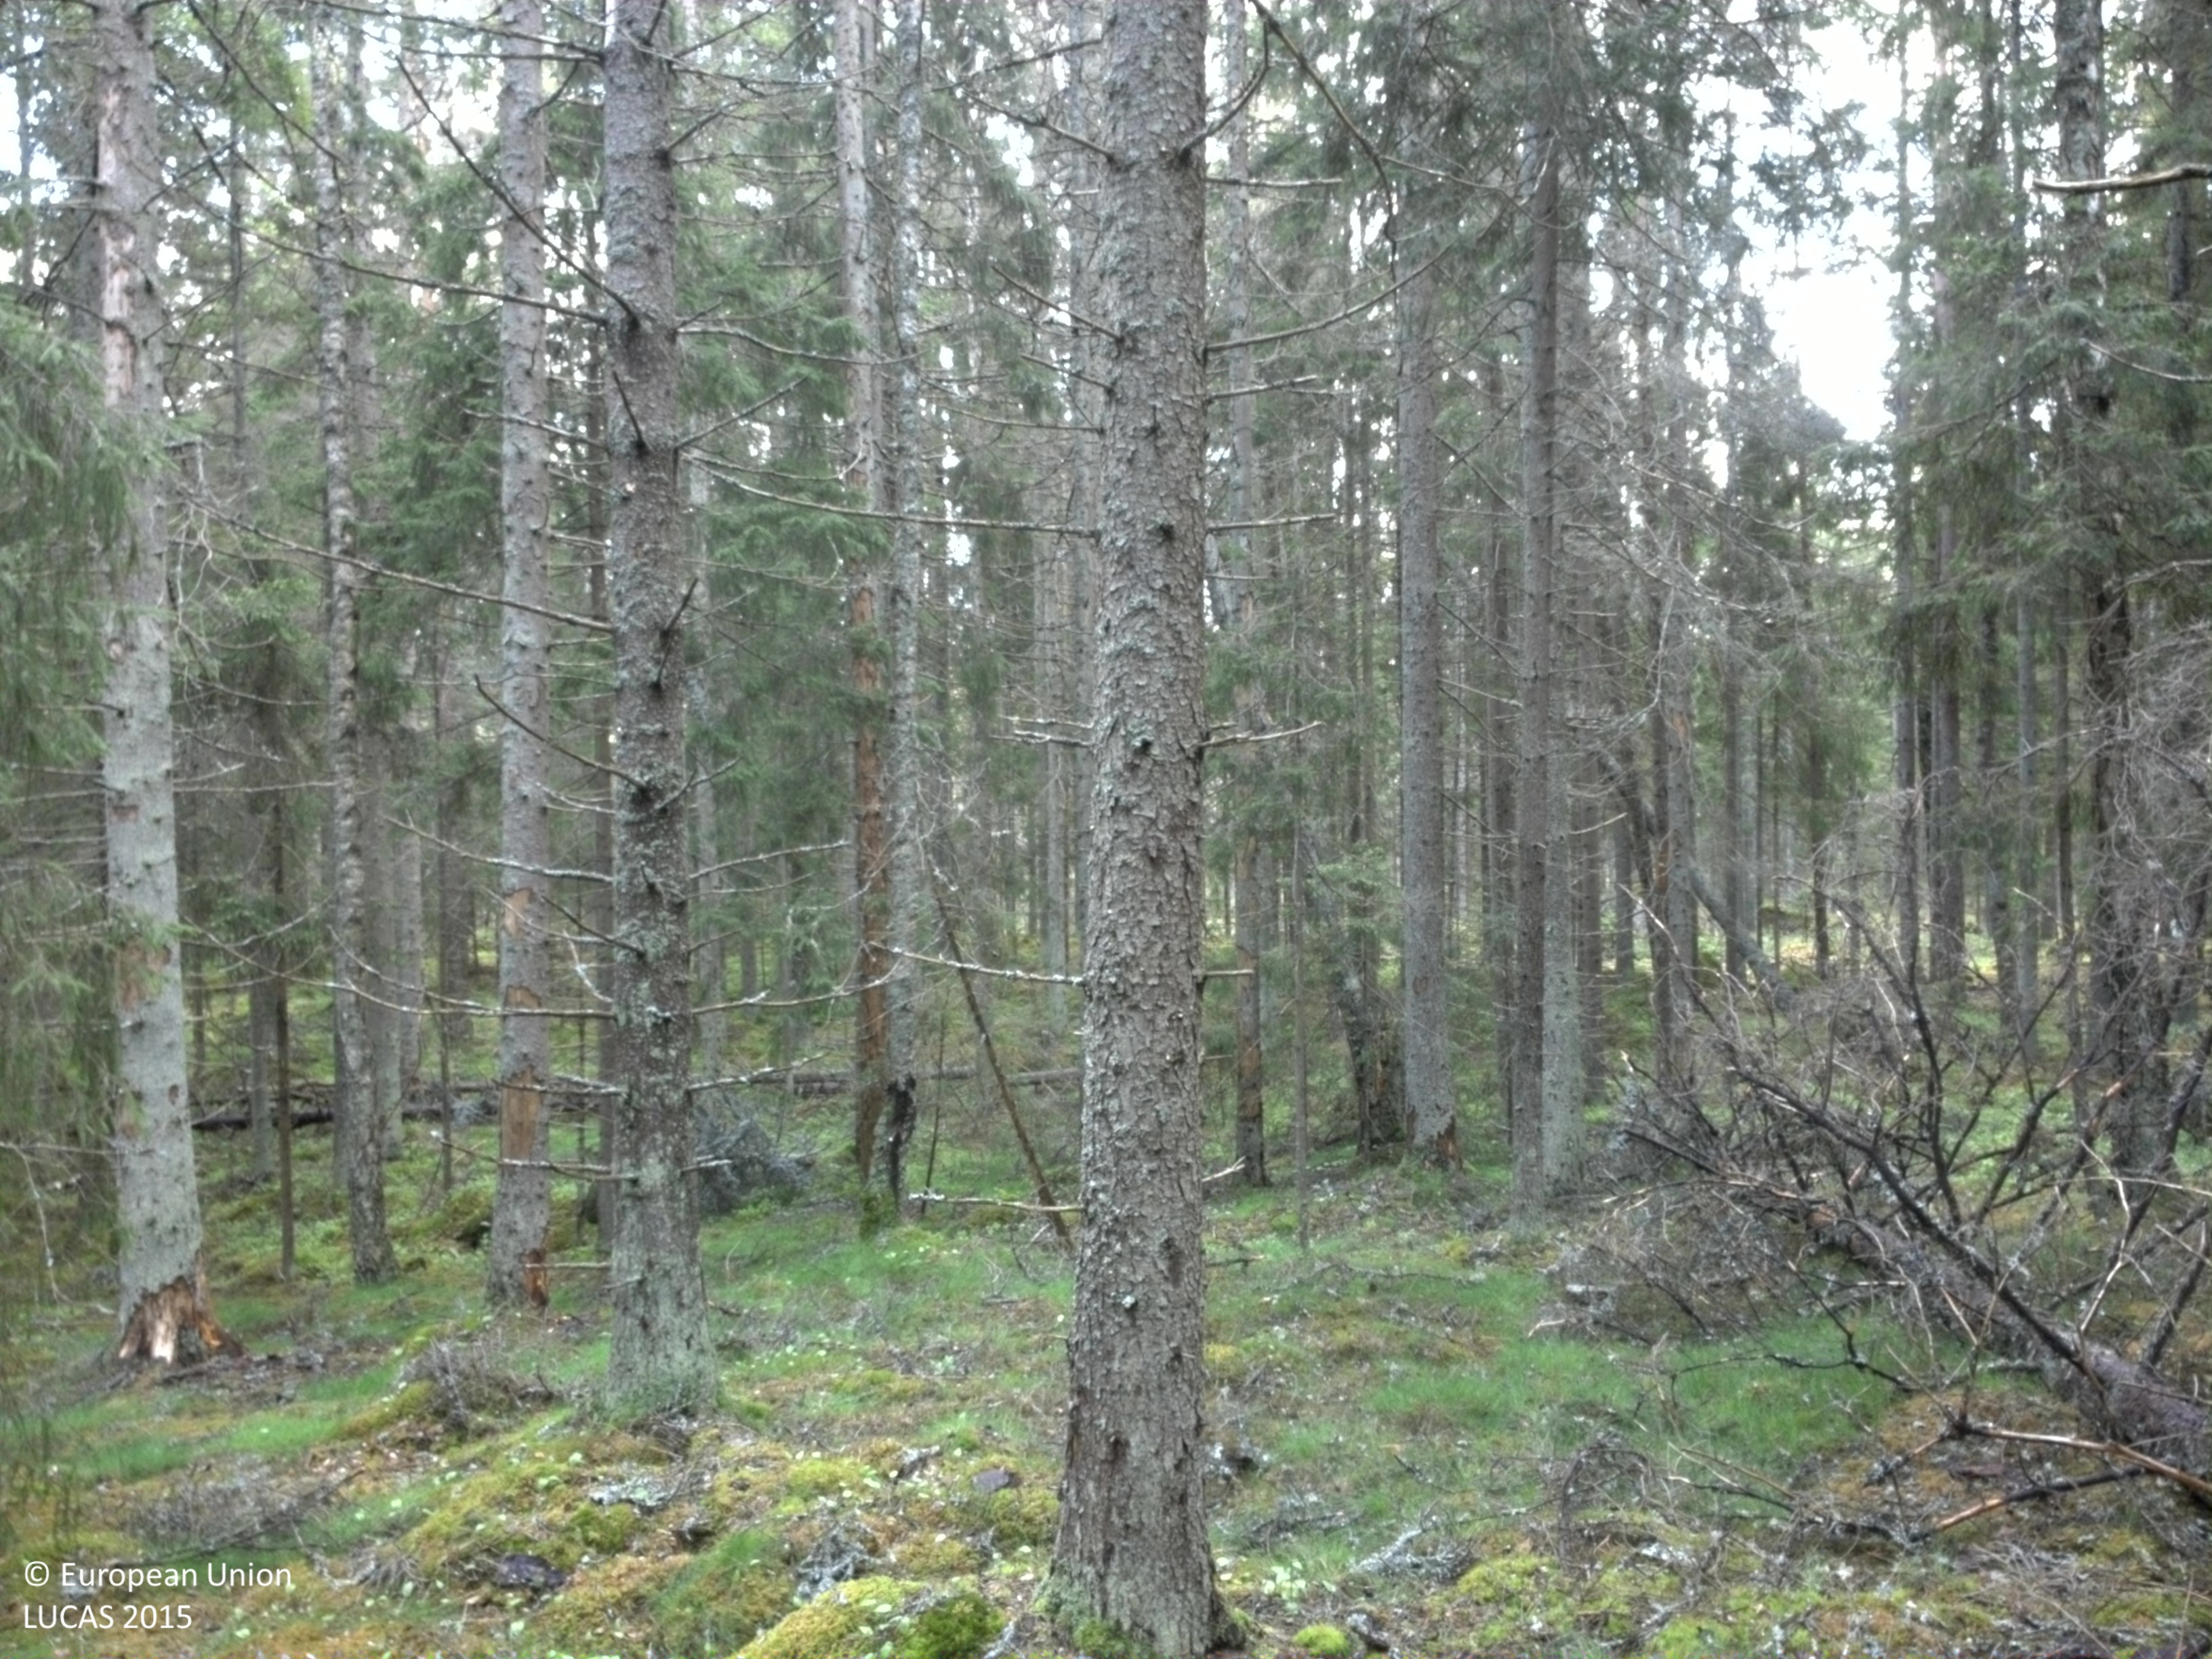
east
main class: Woodland
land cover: Spruce dominated coniferous woodland
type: boreal forest
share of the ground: 50 - 75 %
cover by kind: coniferous forest trees 55 %, lichens and mosses 35 %, shrubs 5 %, herbaceous plants 5 %
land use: Forestry
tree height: > 5 m
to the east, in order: Spruce dominated coniferous woodland; Spruce dominated mixed woodland; Broadleaved woodland; Ditches and canals; Spruce dominated mixed woodland
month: May
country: SE
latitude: 56.8434
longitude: 15.0961
